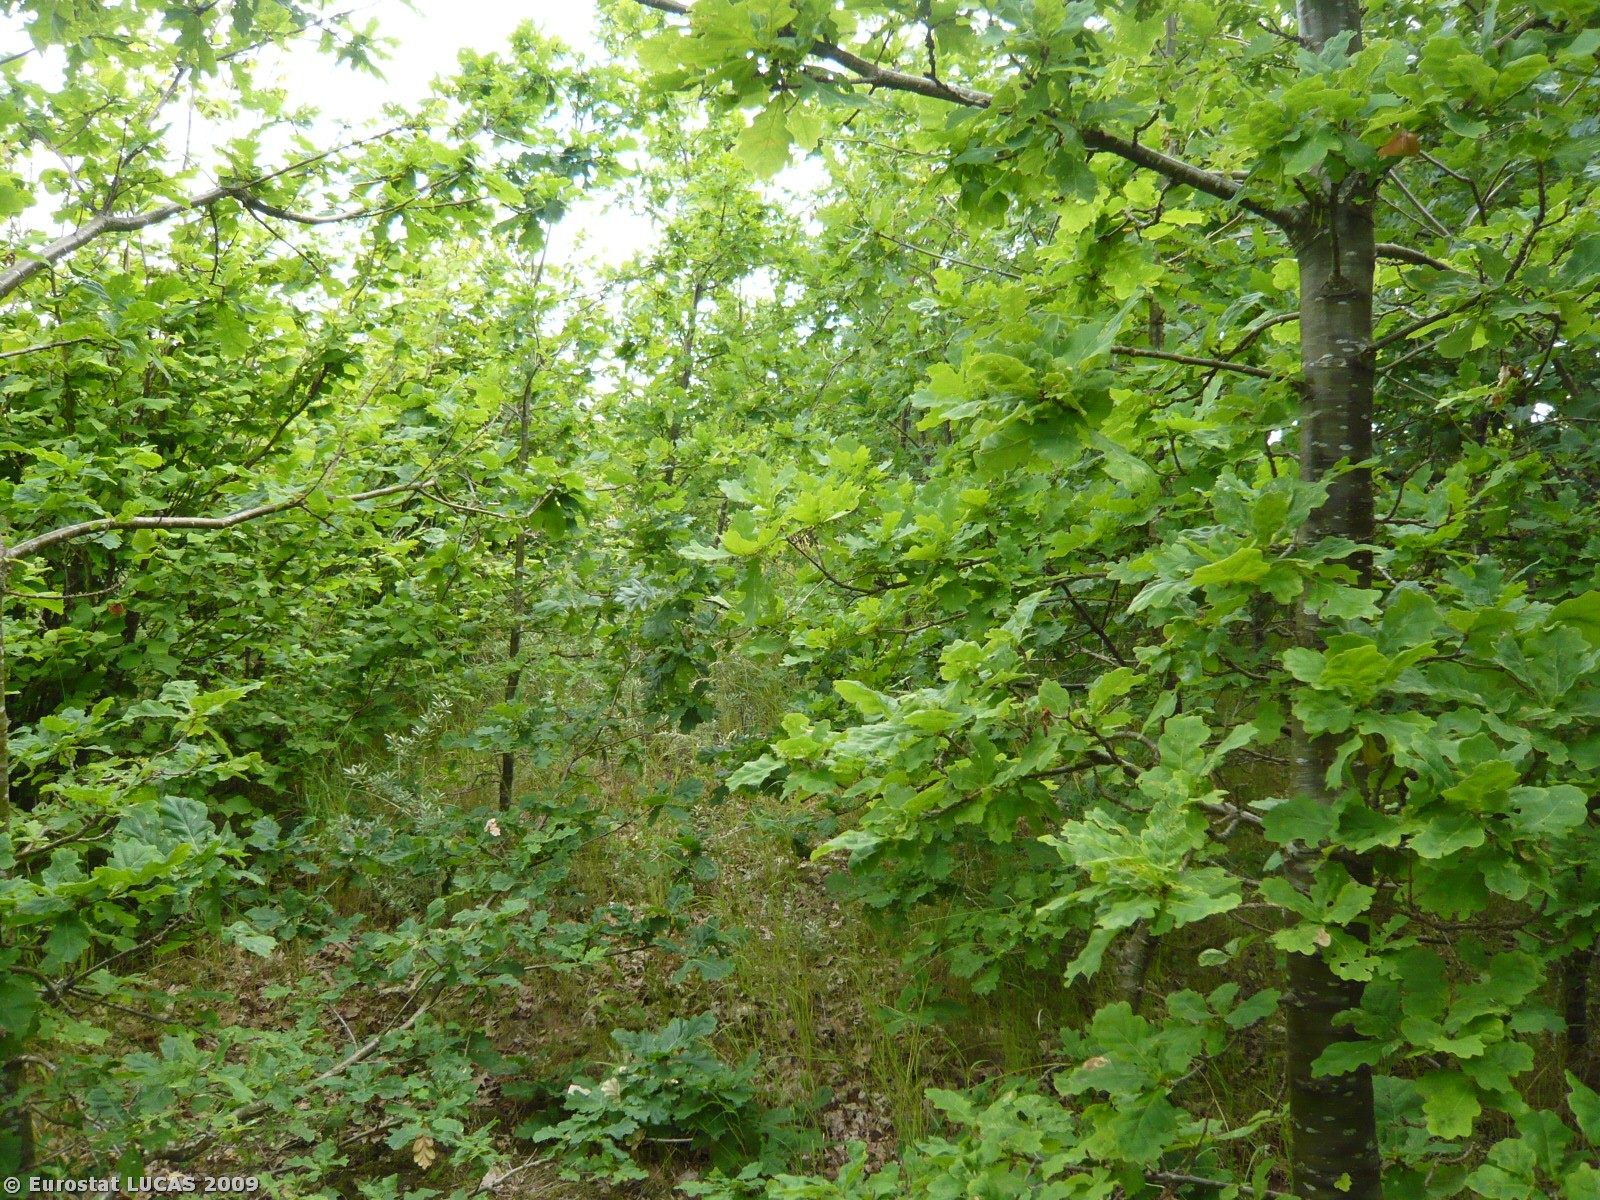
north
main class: Woodland
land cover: Broadleaved woodland
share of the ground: > 75 %
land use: Forestry
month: June
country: DK
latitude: 55.1991
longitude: 10.1413
